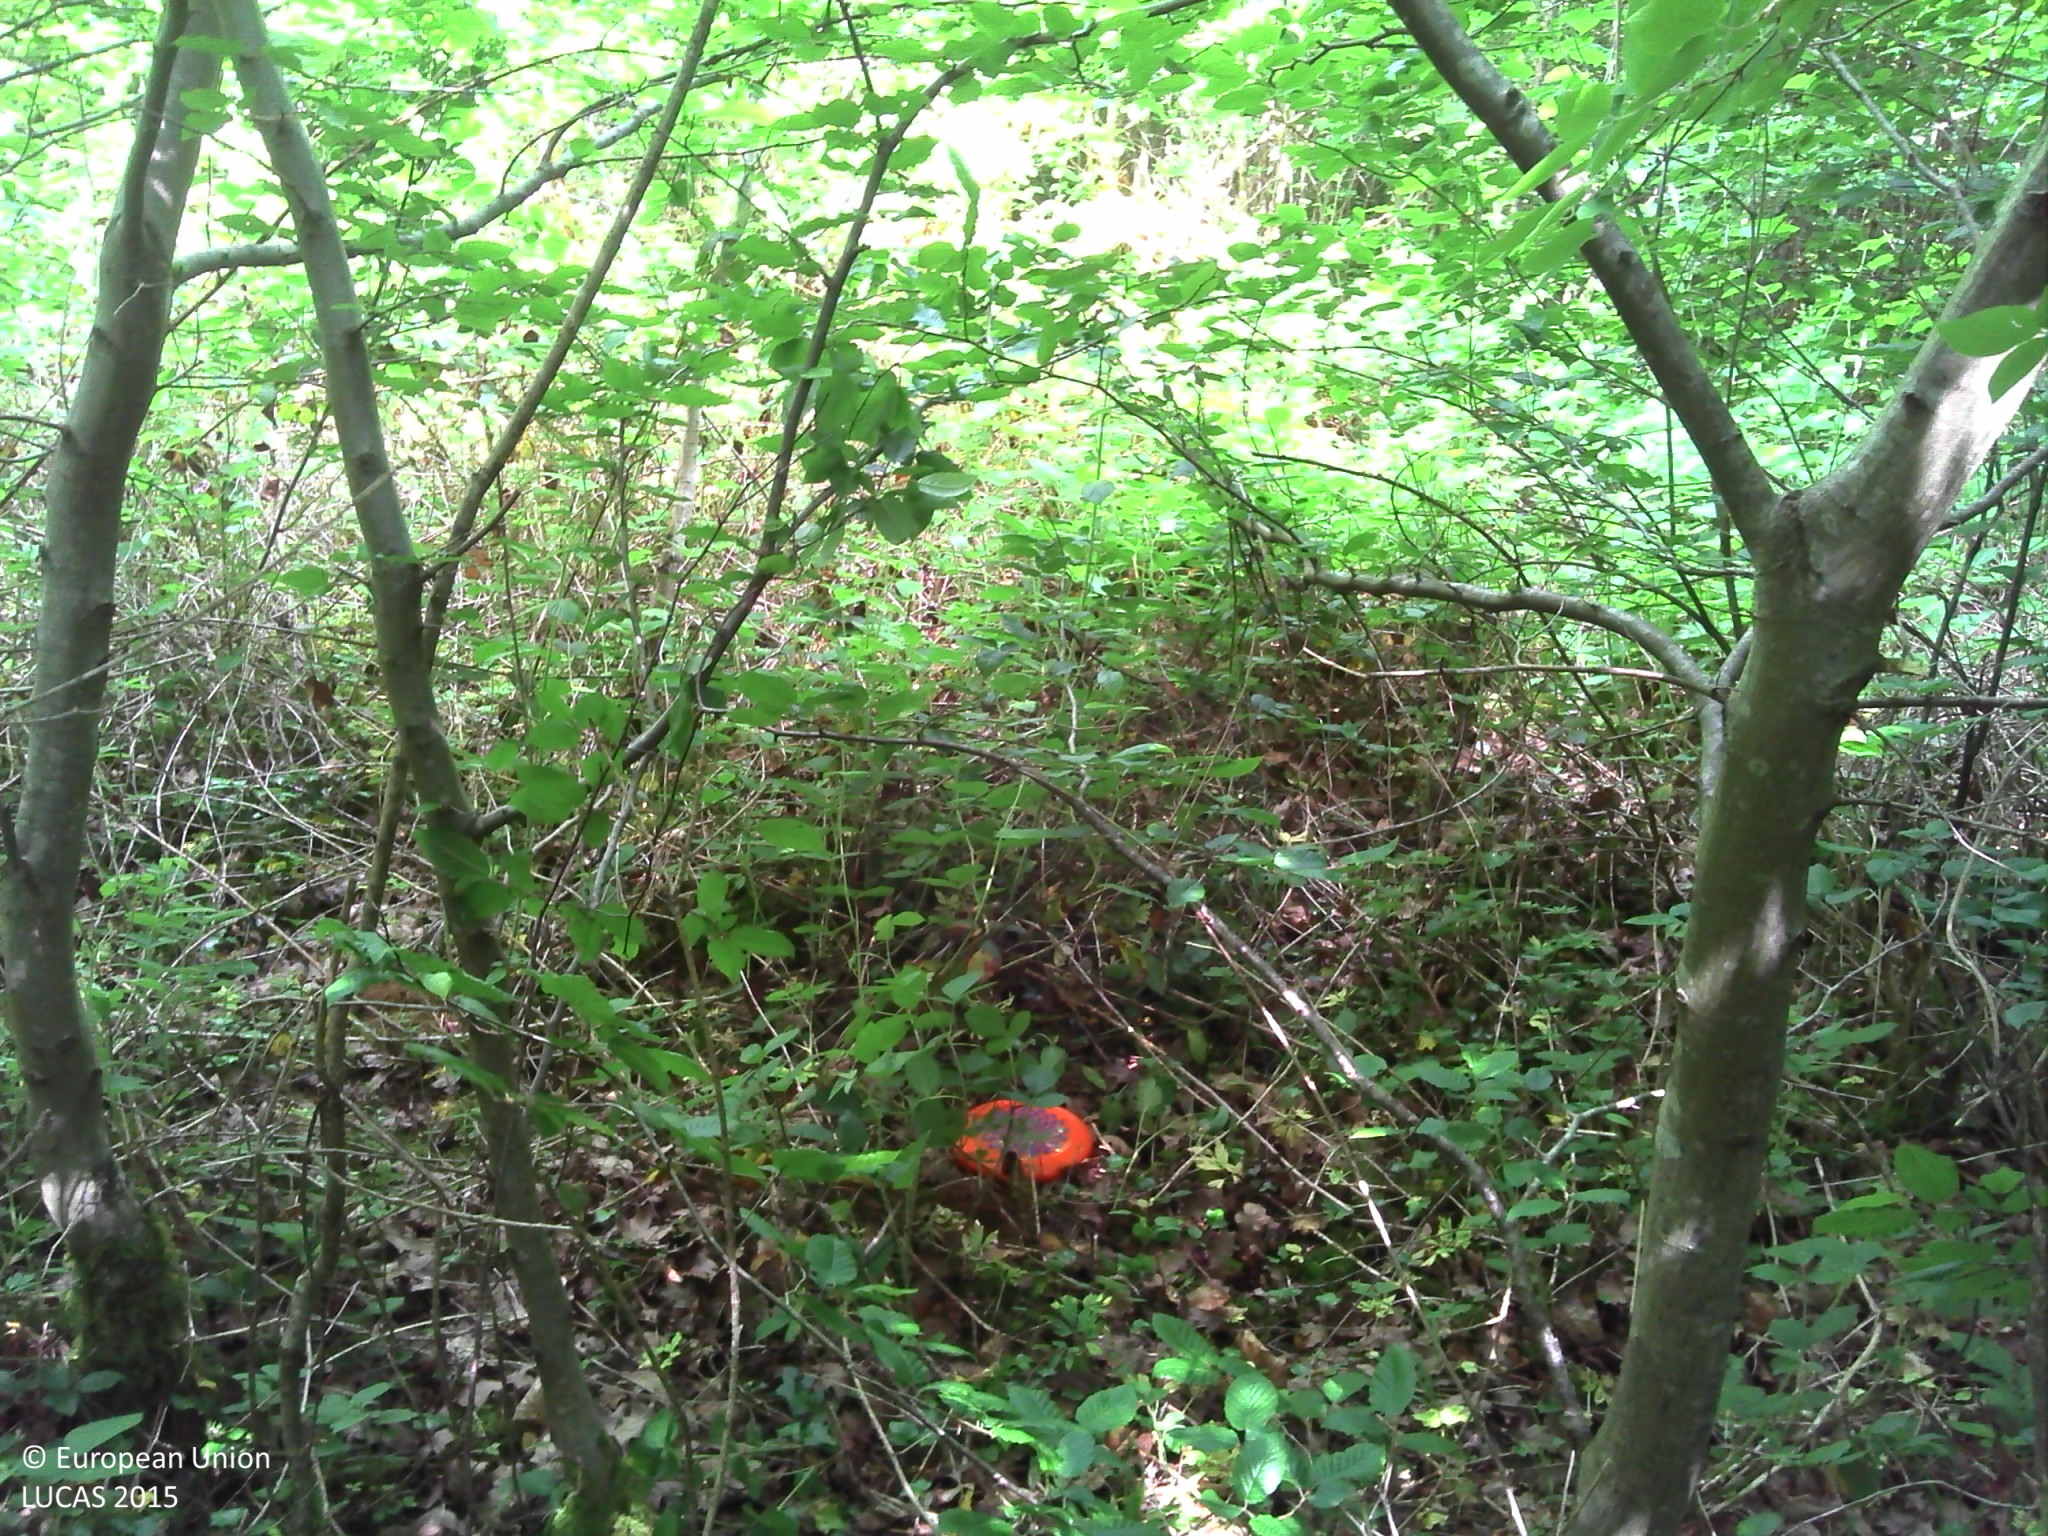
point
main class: Woodland
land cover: Broadleaved woodland
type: mesophytic deciduous forest
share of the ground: > 75 %
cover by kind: broadleaved forest trees 90 %, herbaceous plants 5 %, lichens and mosses 5 %
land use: Forestry
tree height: > 5 m
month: May
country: FR
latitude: 47.7888
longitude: 4.3250
